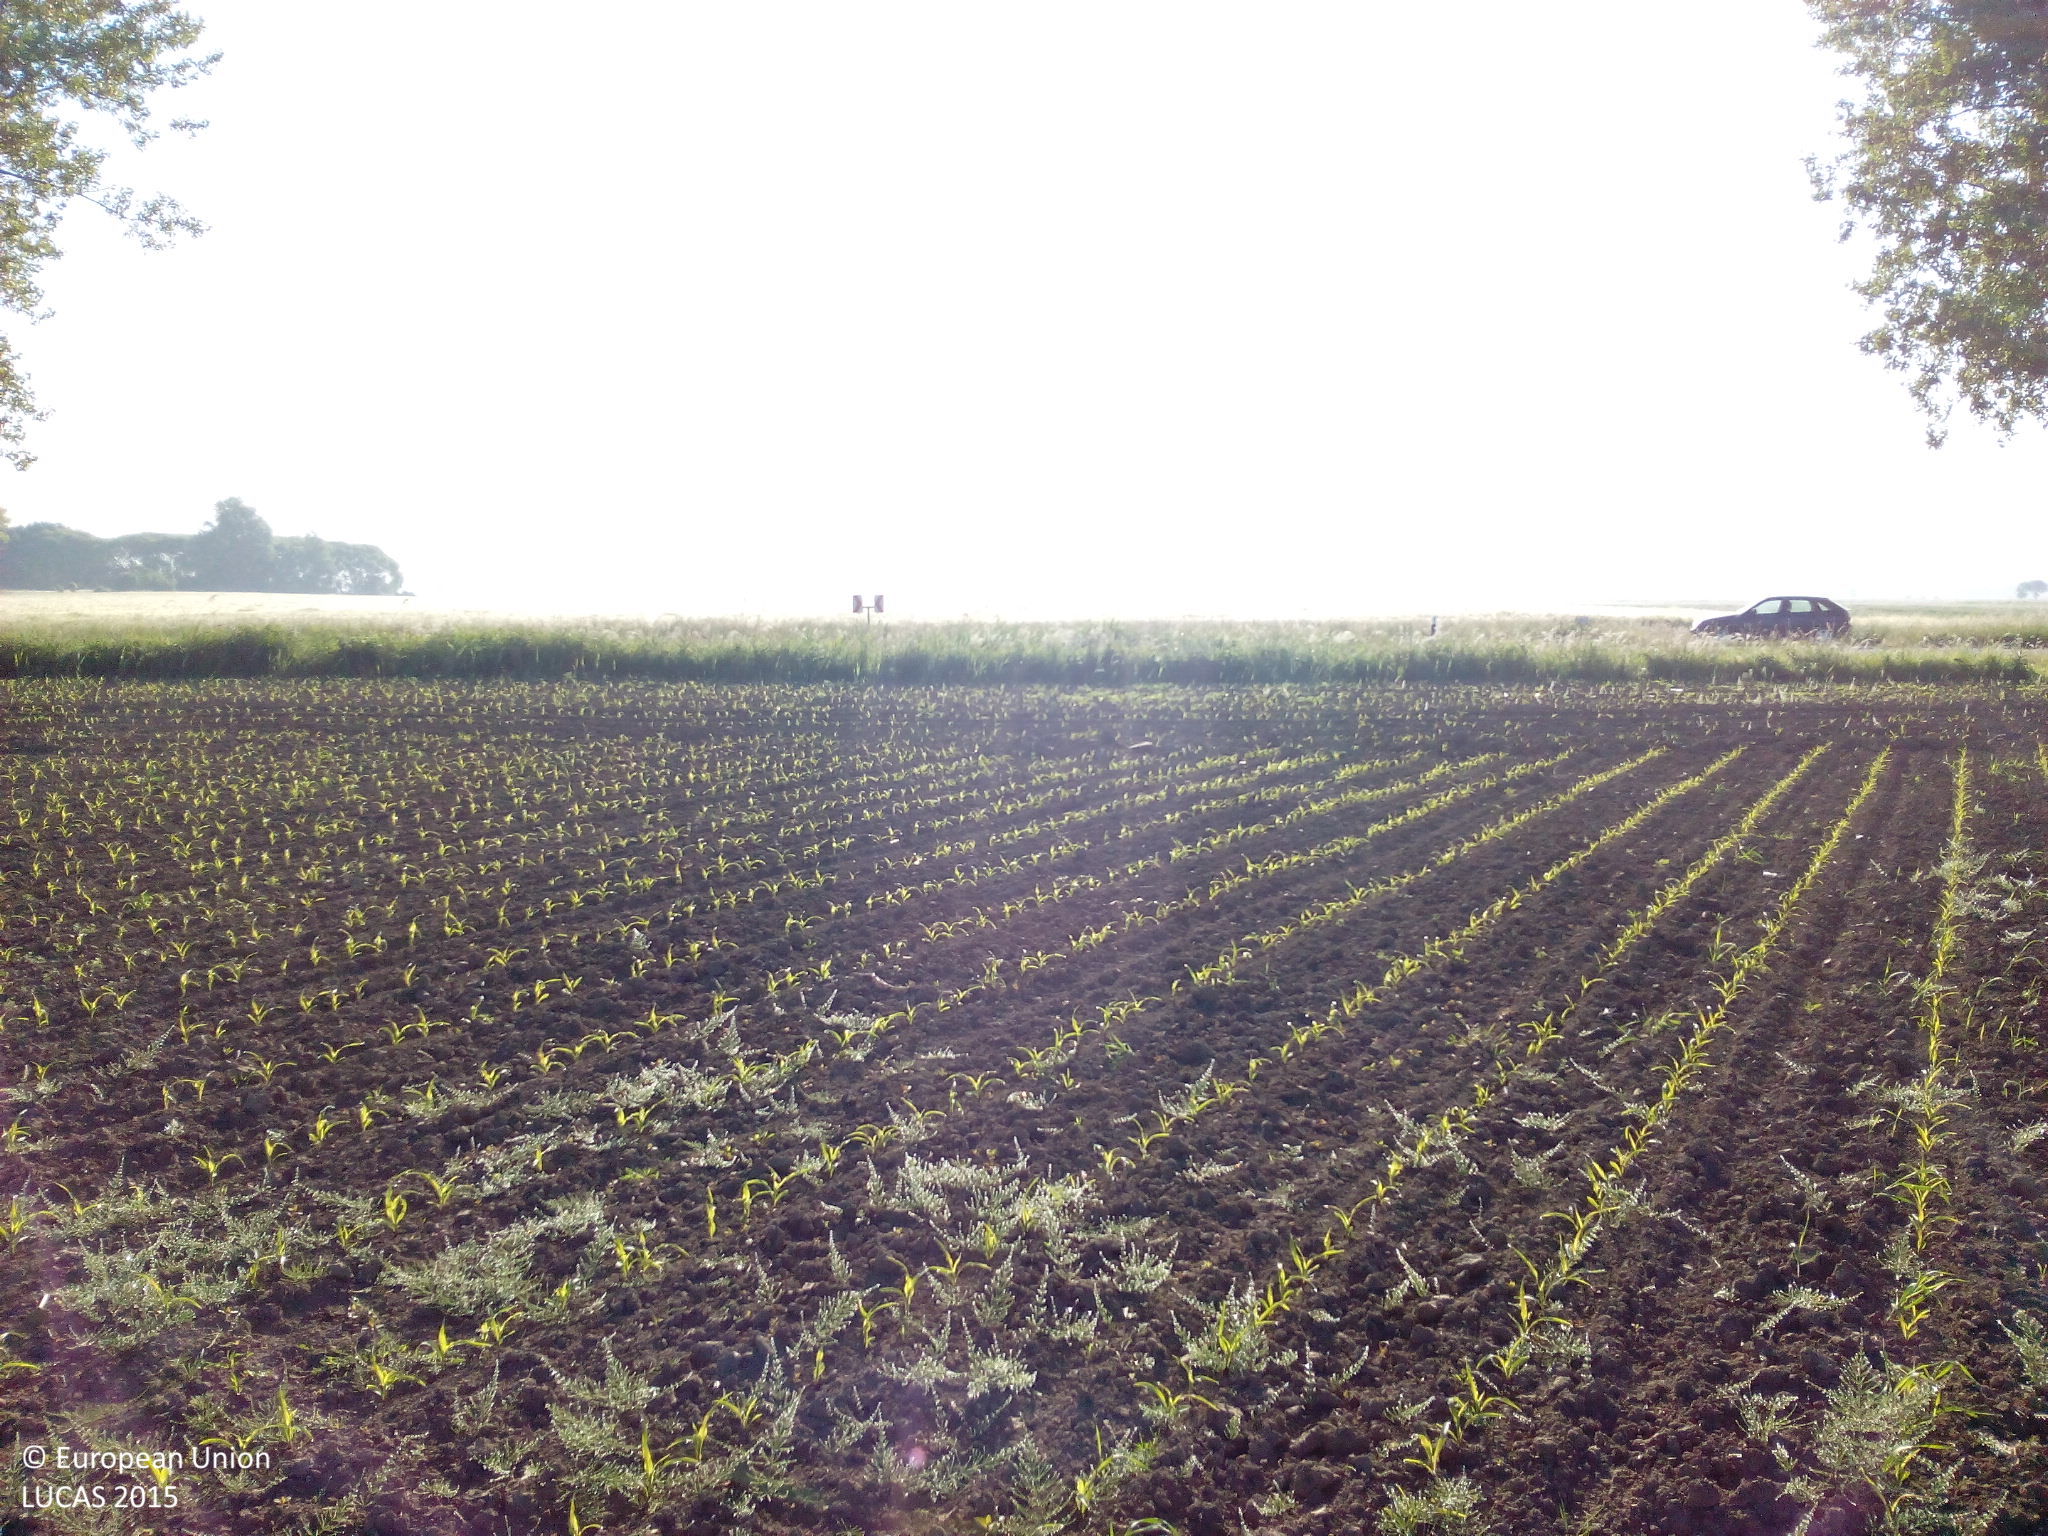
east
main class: Cropland
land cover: Maize
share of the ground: < 10 %
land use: Agriculture (excluding fallow land and kitchen gardens)
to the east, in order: Maize; Grass margins; Ditches and canals; Grass margins; Paved roads, cycling and walking lanes; Grass margins; Tracks; Grass margins; Barley; Grass margins; Ditches and canals; Grass margins; Common wheat
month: June
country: DE
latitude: 53.2490
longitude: 8.5169
